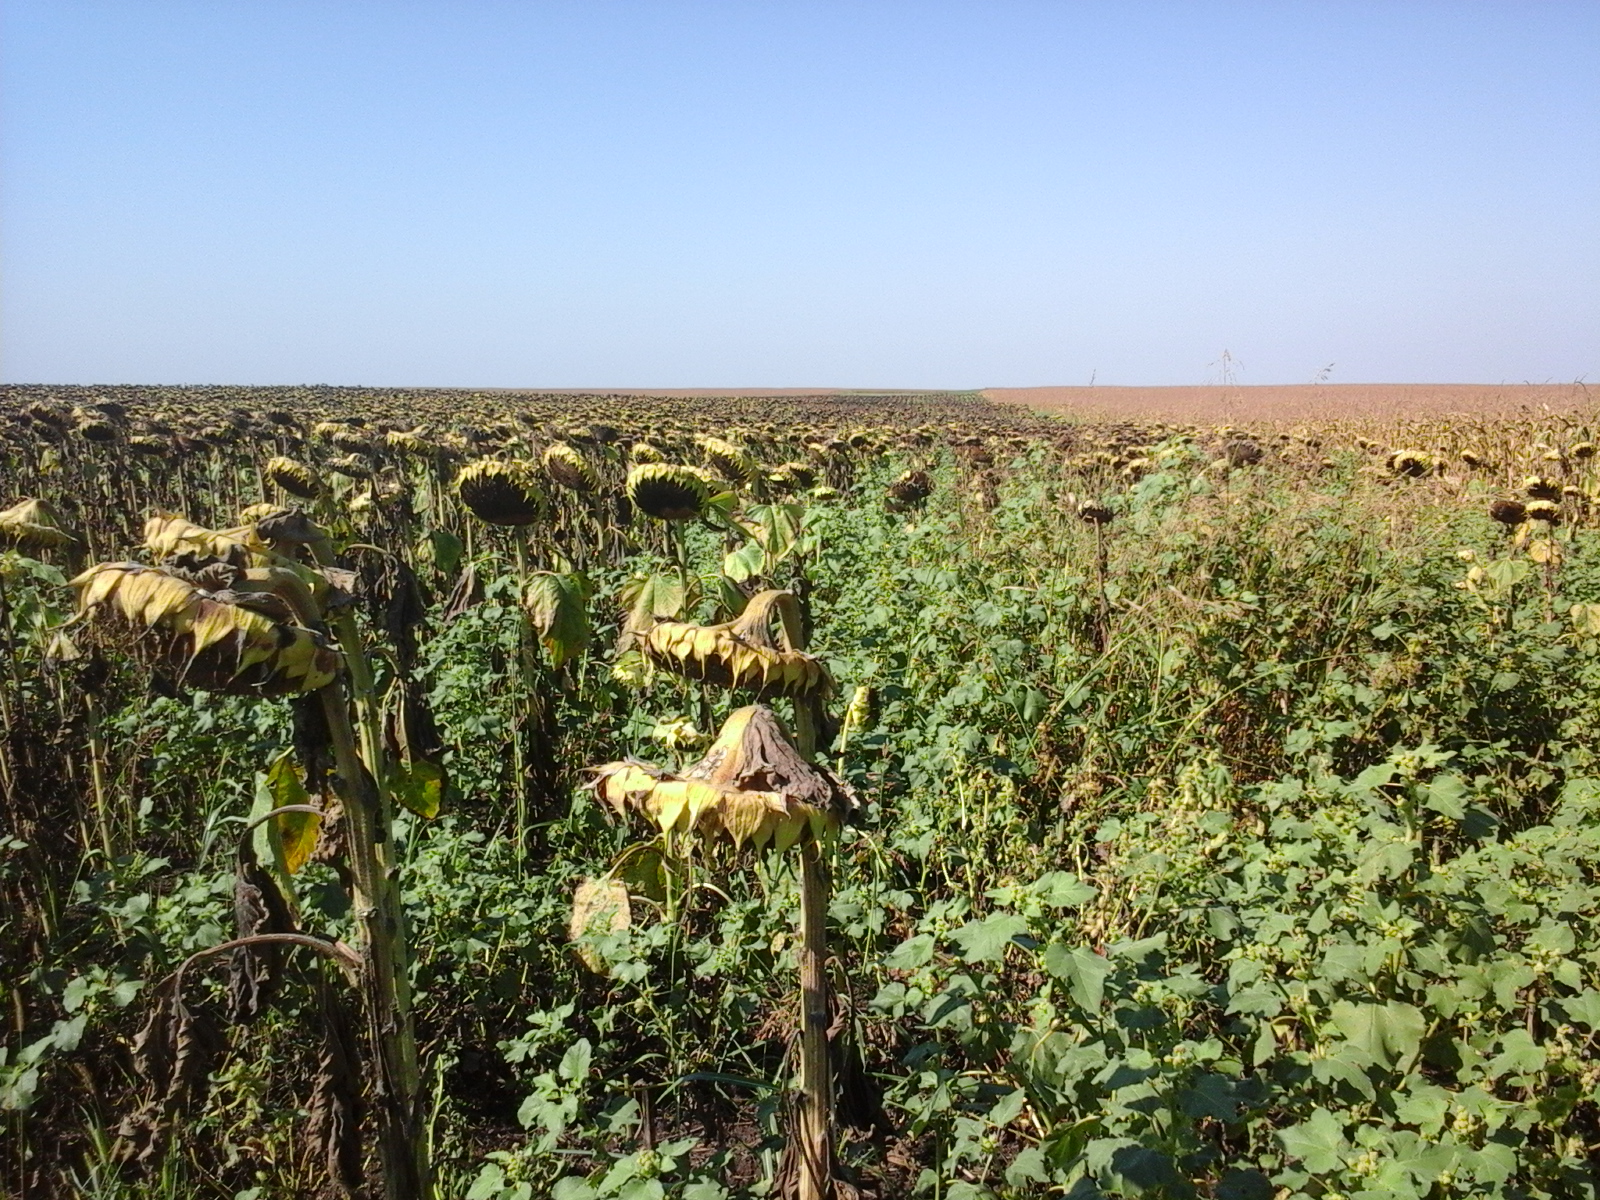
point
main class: Cropland
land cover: Sunflower
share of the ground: > 75 %
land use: Agriculture (excluding fallow land and kitchen gardens)
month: August
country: RO
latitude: 46.0721
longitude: 21.0067
